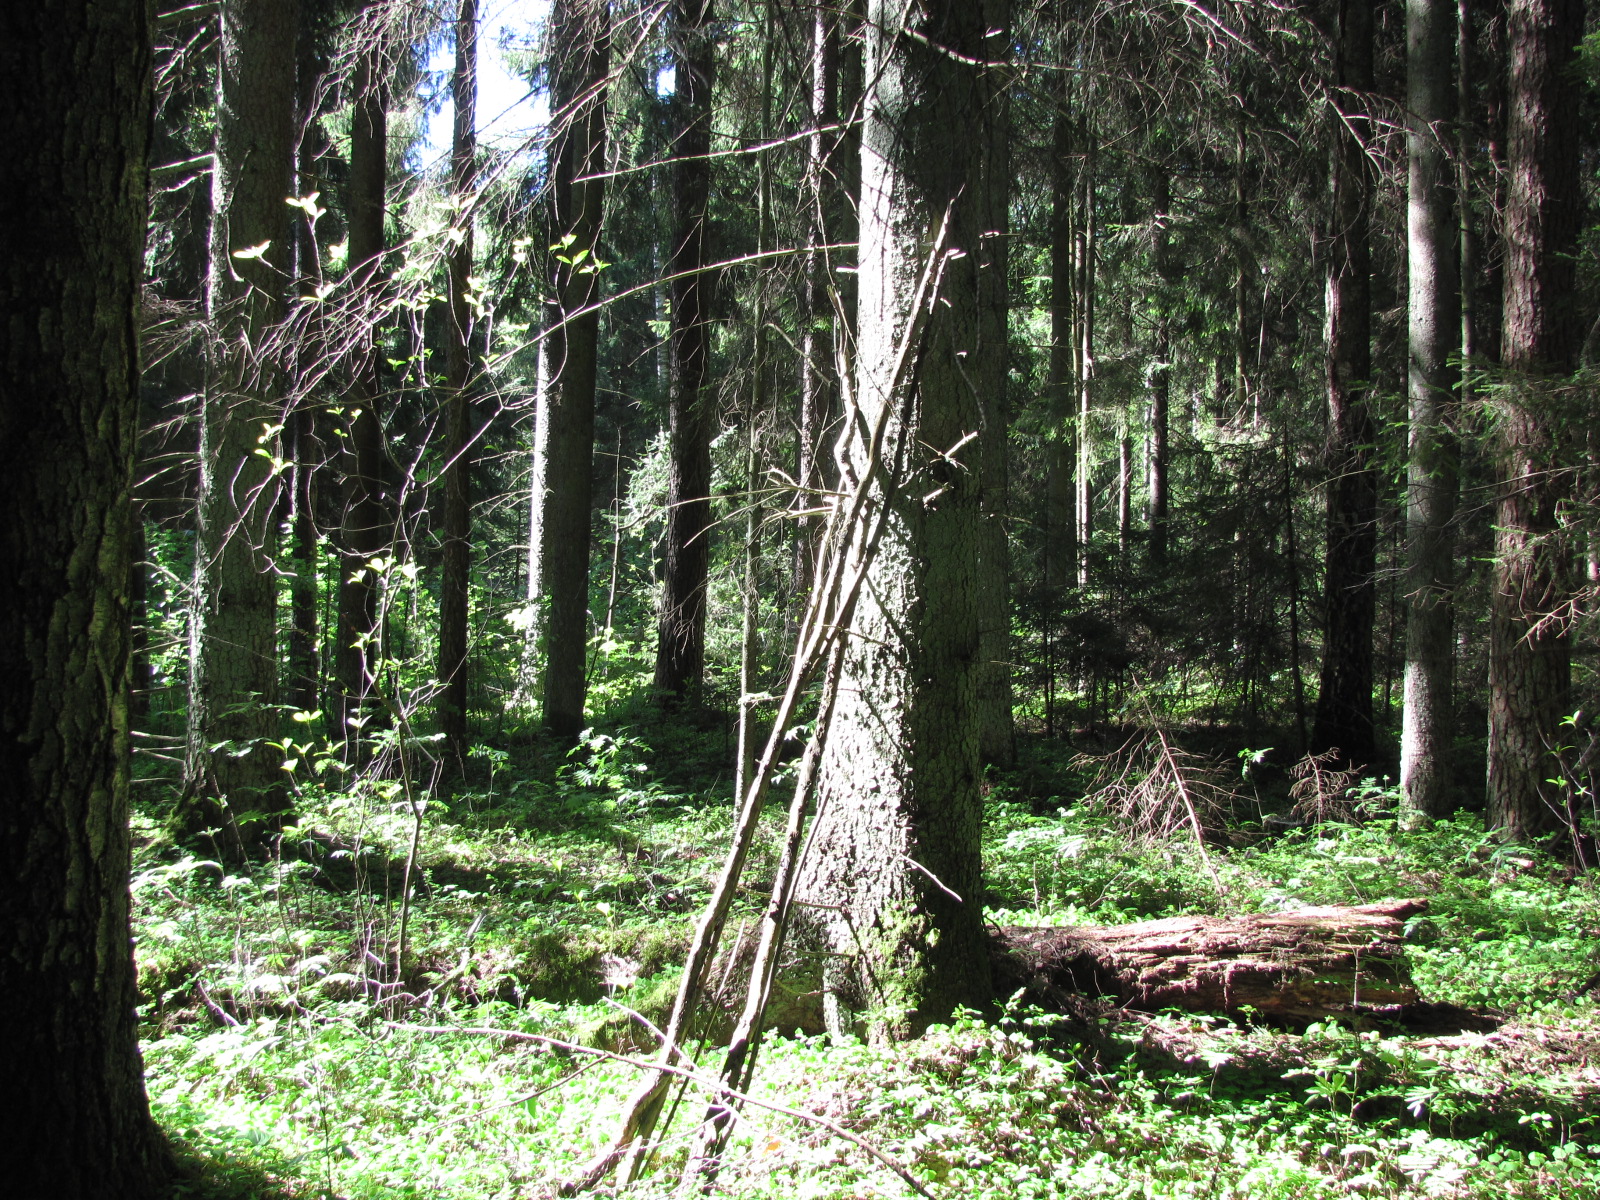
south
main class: Woodland
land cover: Other coniferous woodland
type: hemiboreal forest and nemoral coniferous forest and mixed broadleaved-coniferous forest
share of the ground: > 75 %
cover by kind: coniferous forest trees 95 %, broadleaved forest trees 5 %
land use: Forestry
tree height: > 5 m
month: May
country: LV
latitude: 56.6830
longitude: 24.1090
